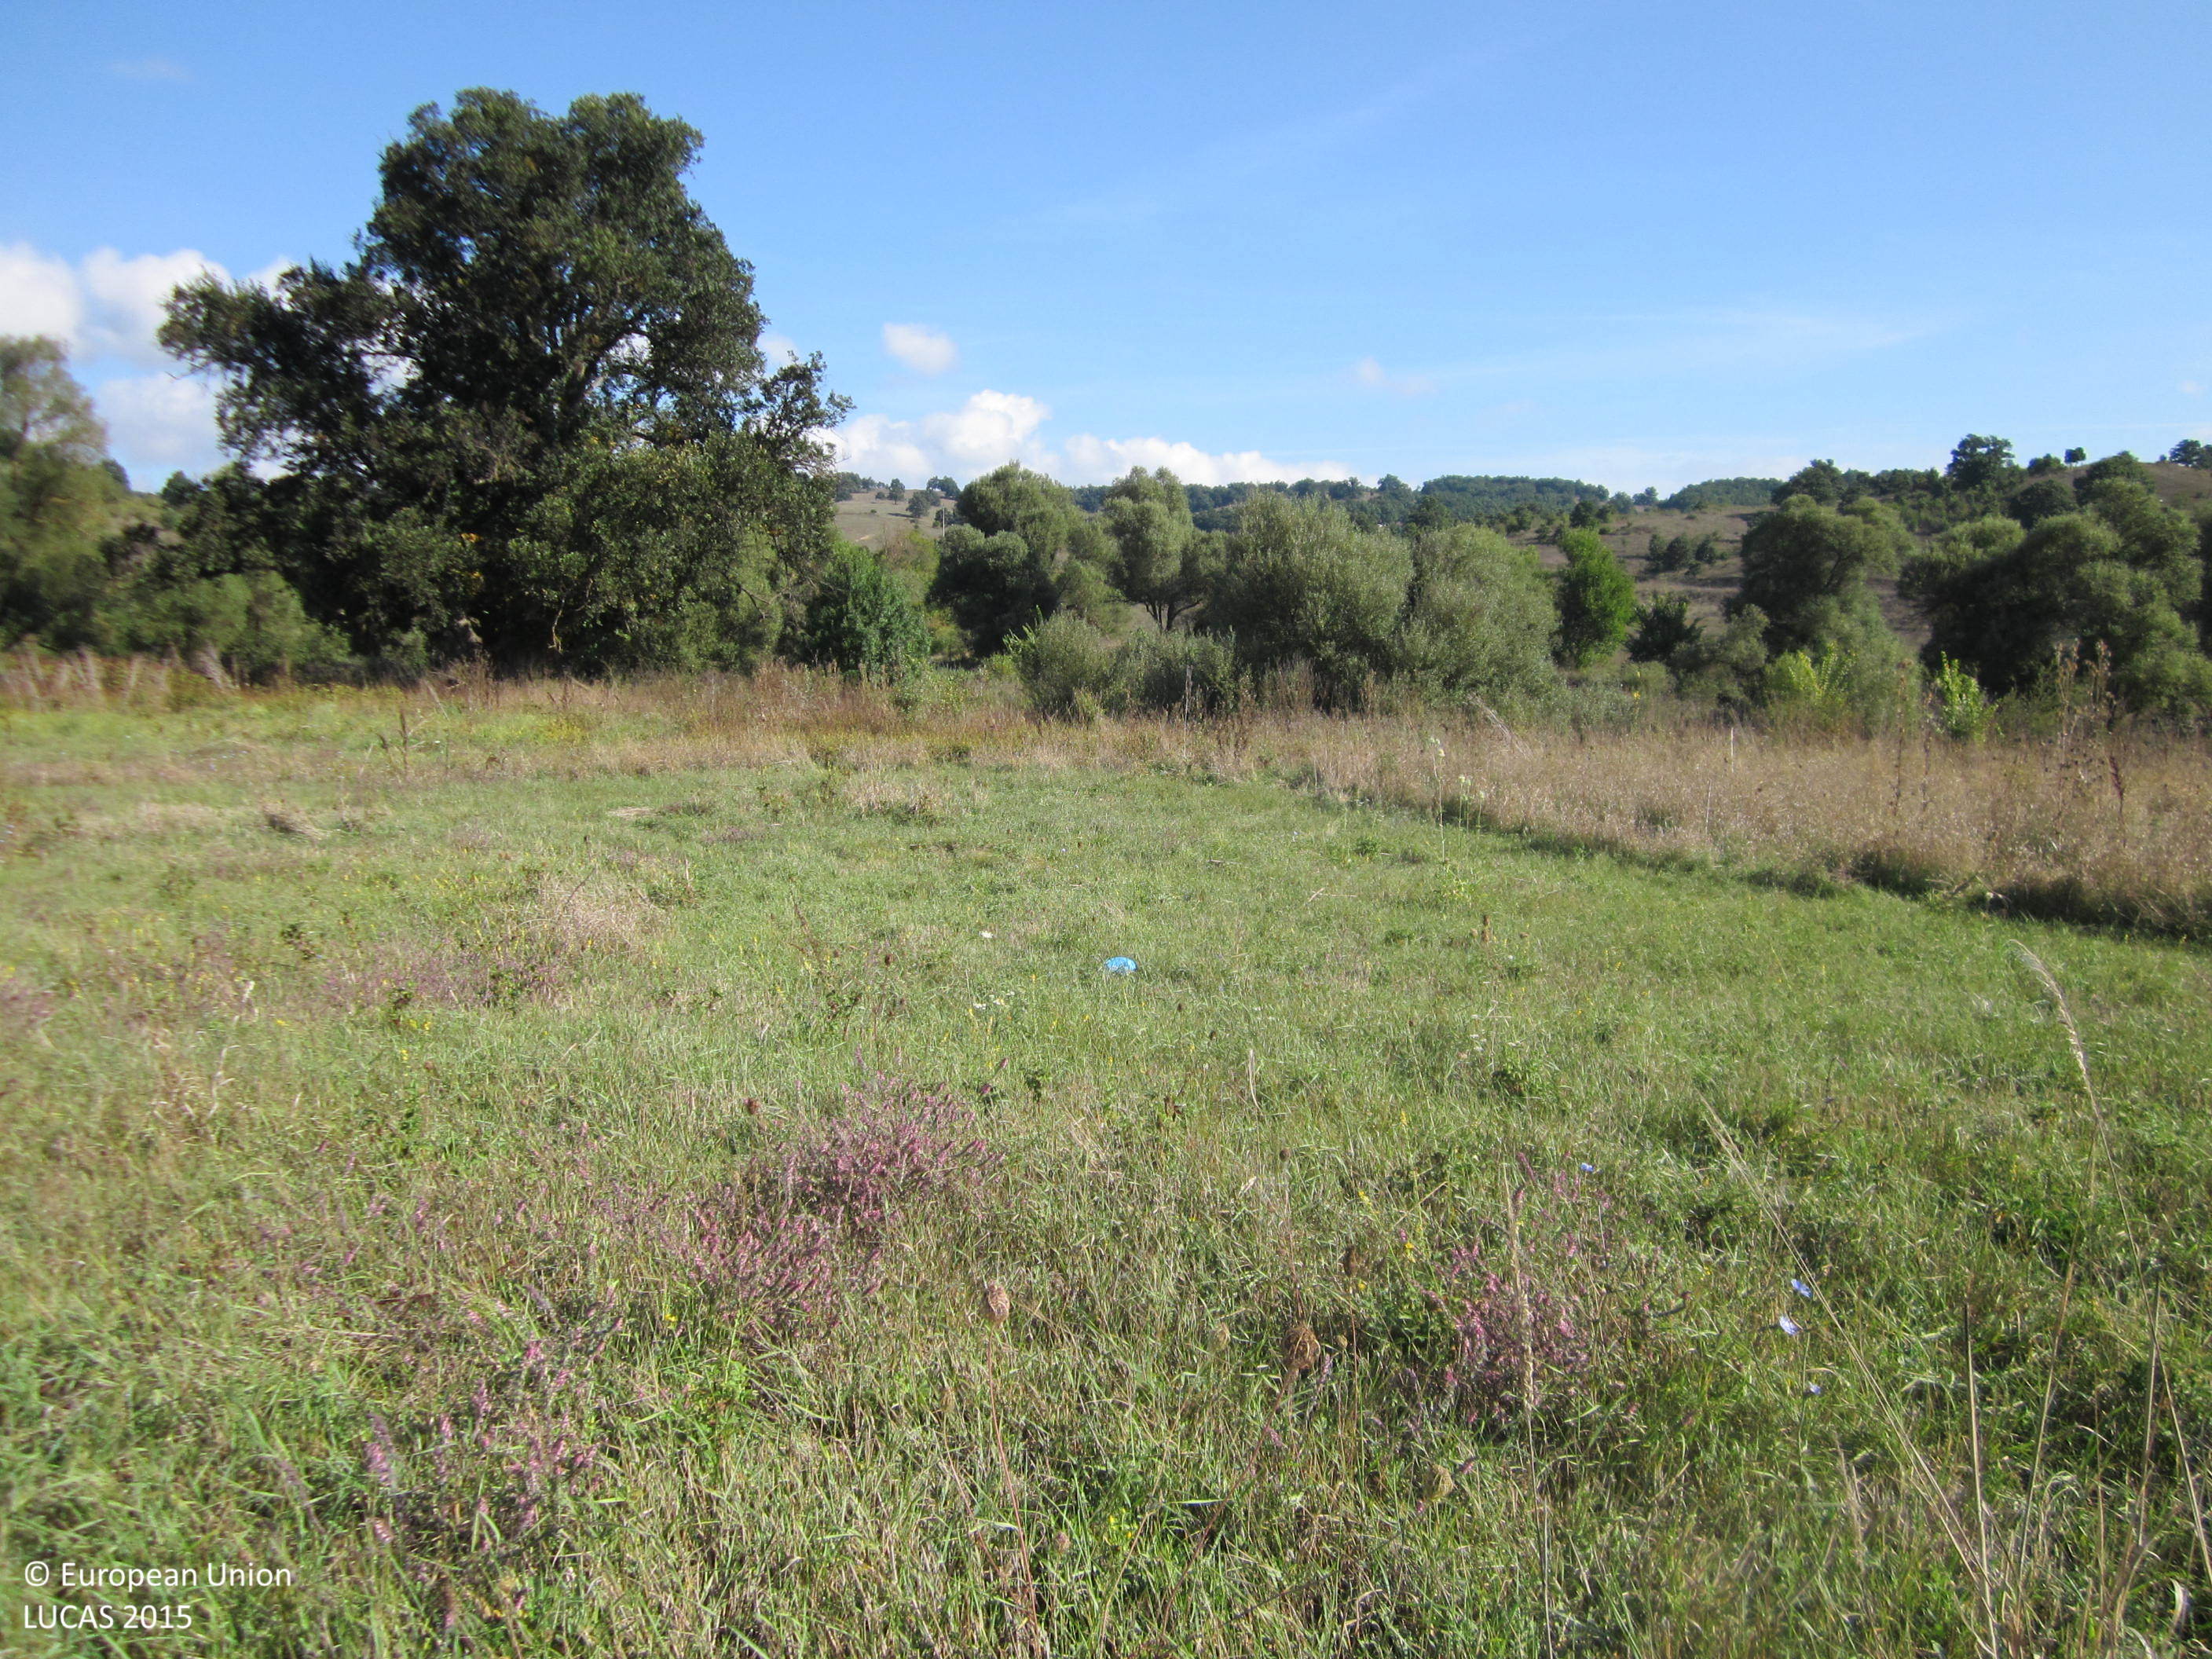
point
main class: Grassland
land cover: Grassland without tree/shrub cover
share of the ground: > 75 %
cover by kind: herbaceous plants 100 %
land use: Agriculture (excluding fallow land and kitchen gardens)
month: September
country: BG
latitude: 42.1794
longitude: 27.1133
